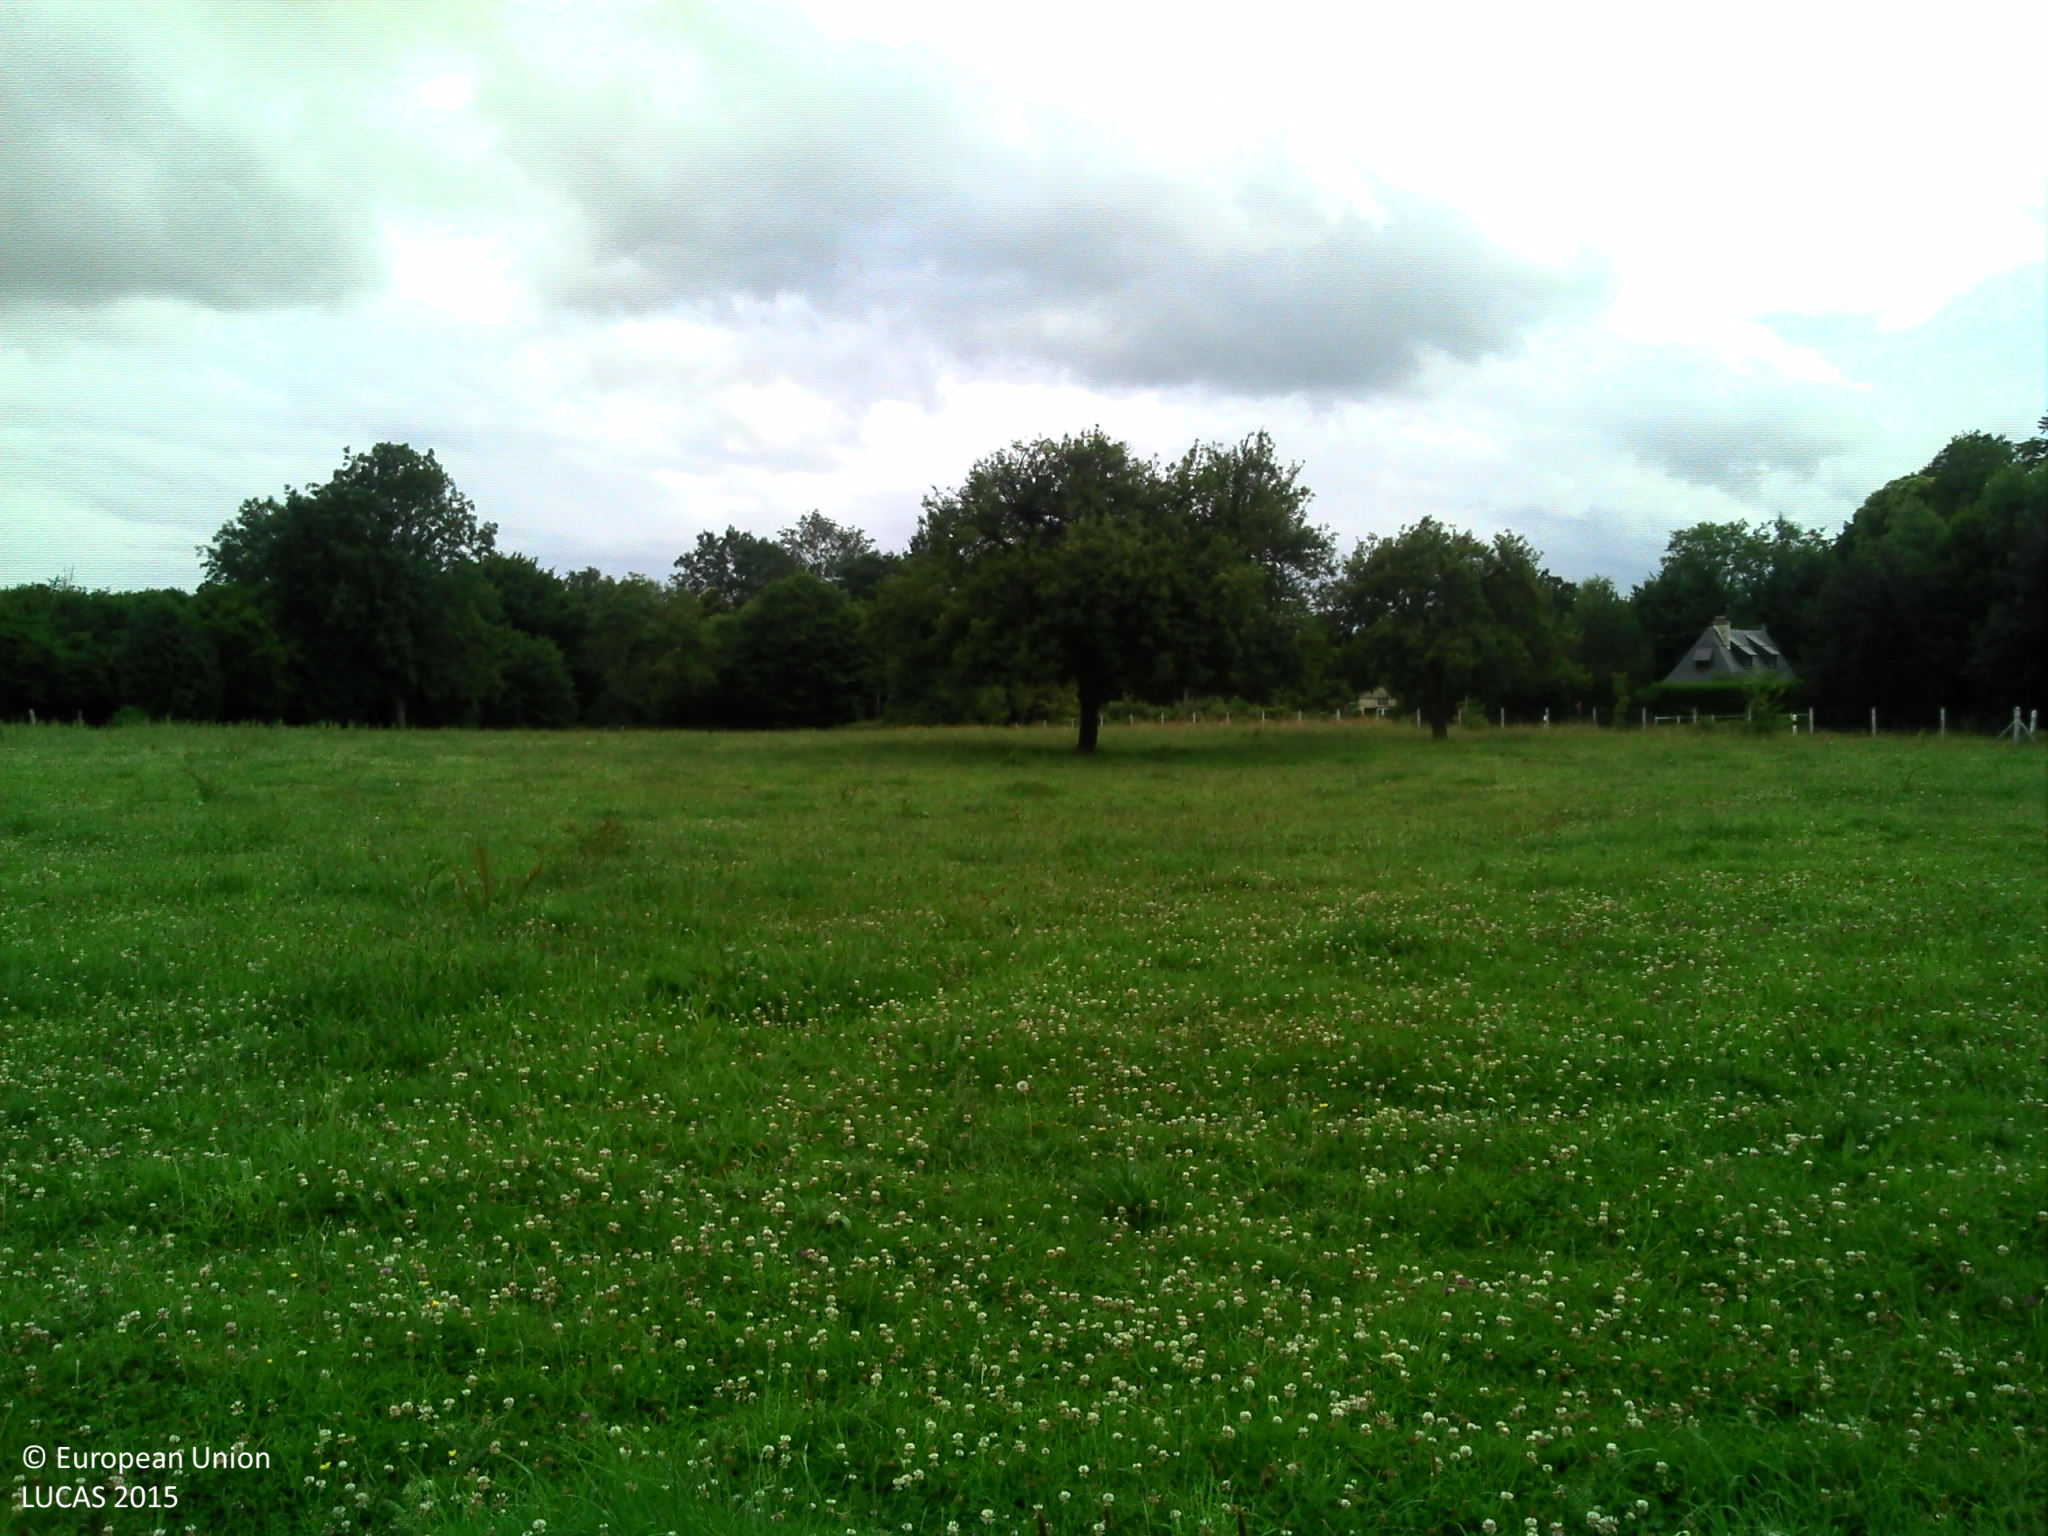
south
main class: Grassland
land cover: Grassland without tree/shrub cover
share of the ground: > 75 %
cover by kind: herbaceous plants 100 %
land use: Agriculture (excluding fallow land and kitchen gardens)
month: July
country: FR
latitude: 49.3727
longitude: 0.3175
